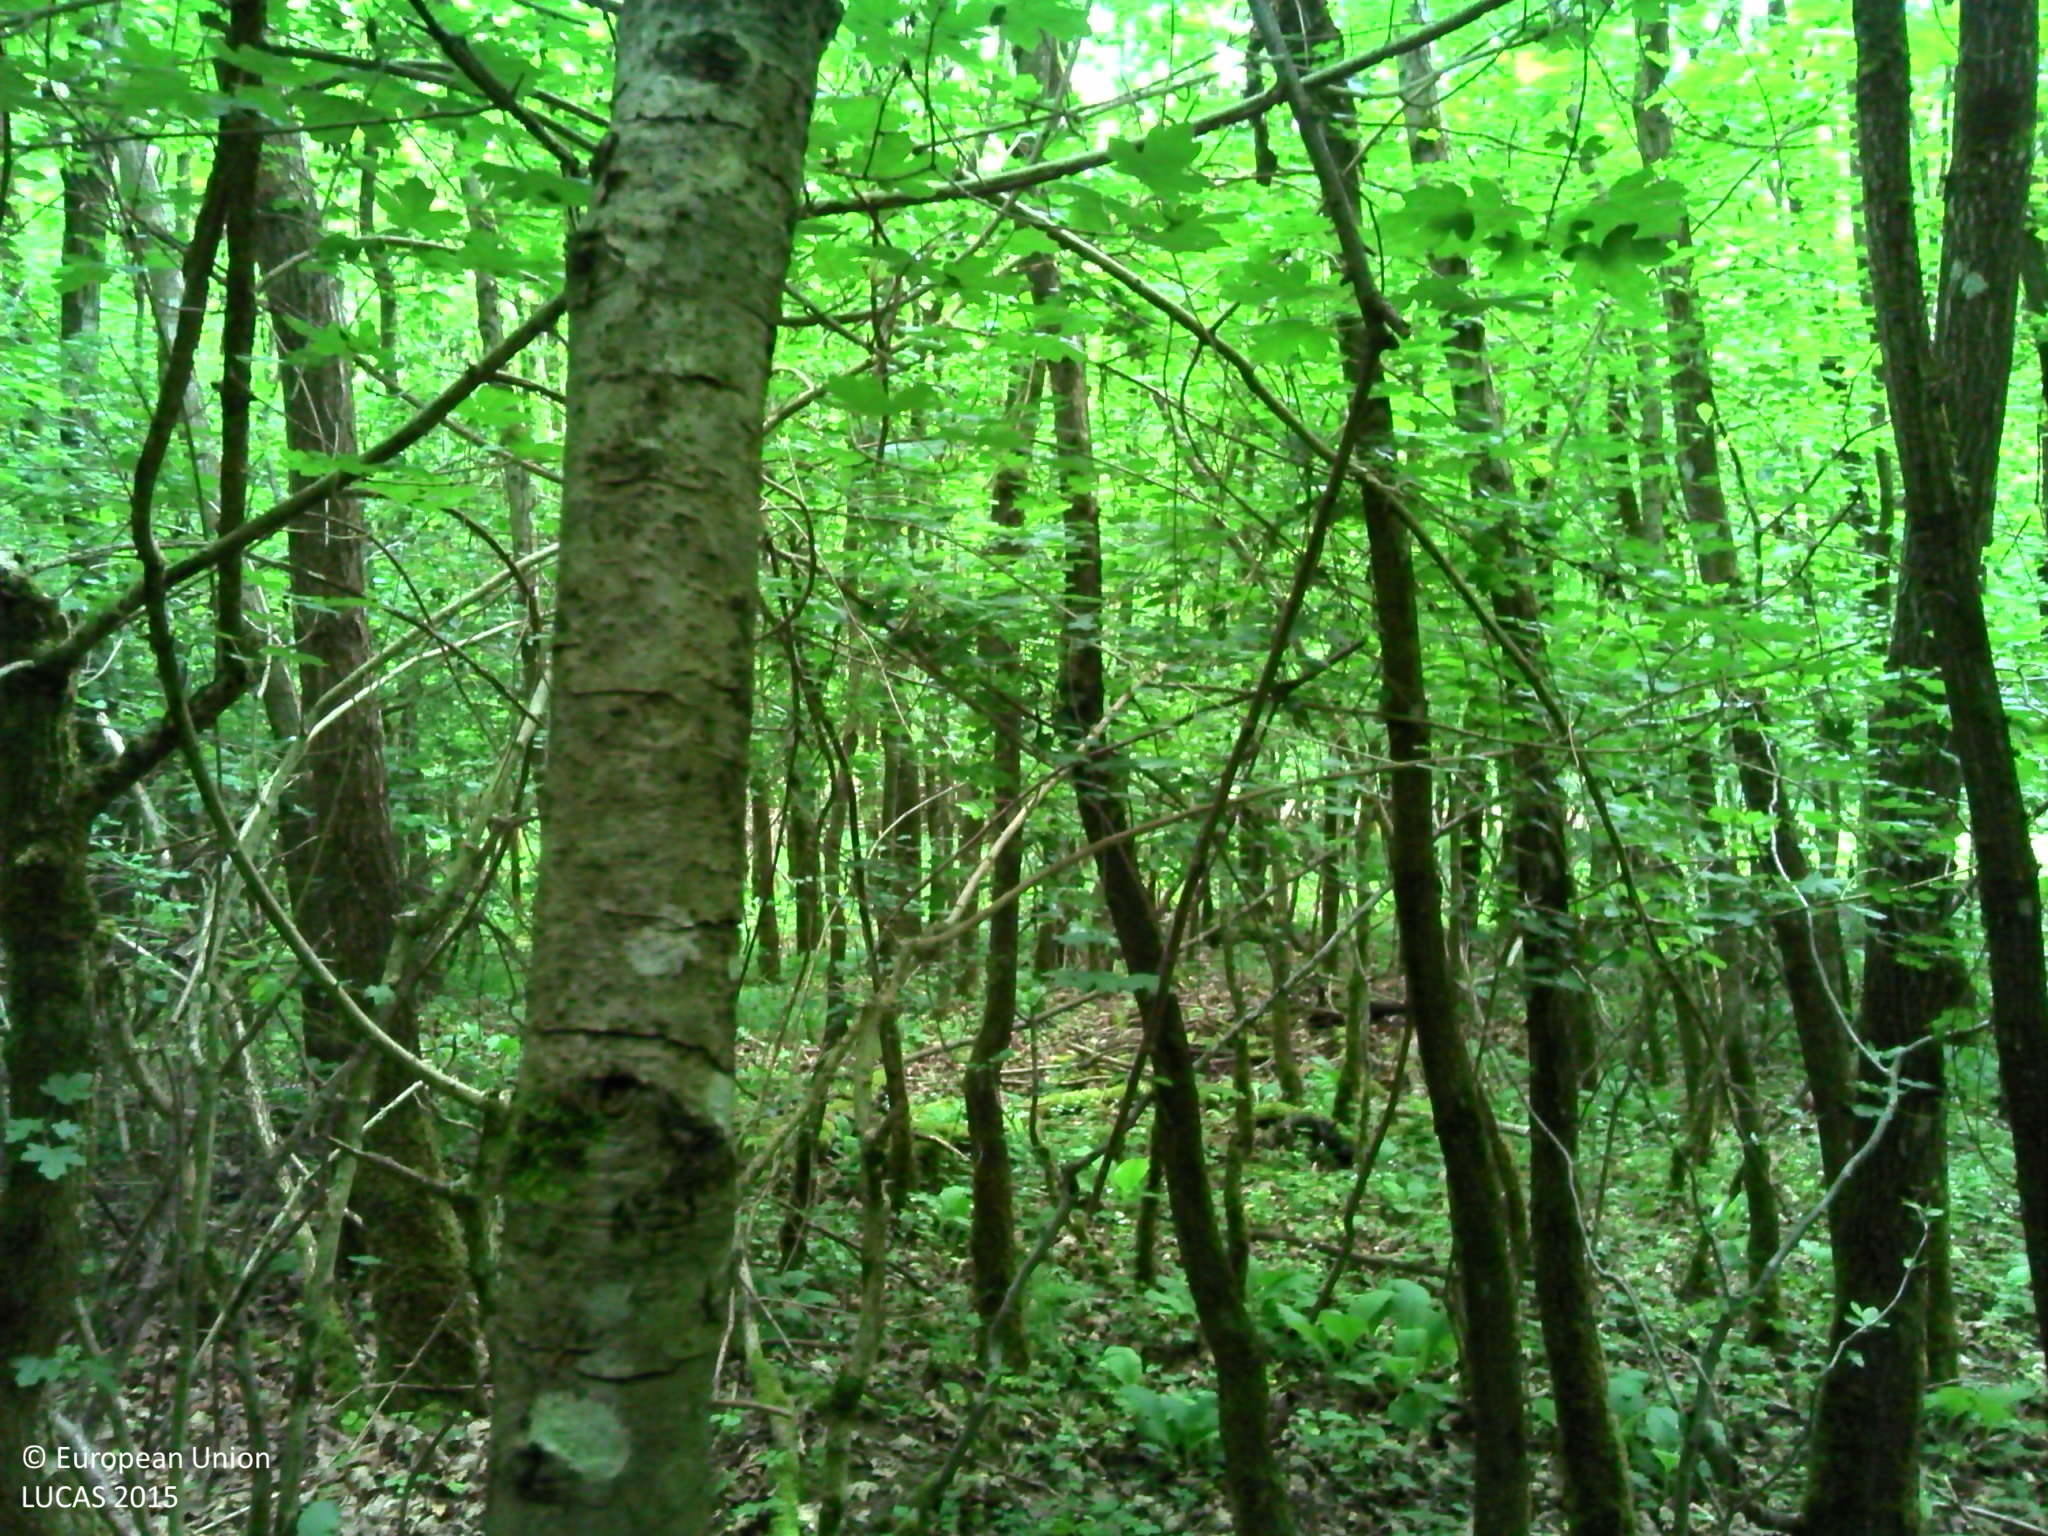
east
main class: Woodland
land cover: Broadleaved woodland
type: mesophytic deciduous forest
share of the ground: > 75 %
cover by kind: broadleaved forest trees 90 %, herbaceous plants 5 %, lichens and mosses 5 %
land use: Forestry
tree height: > 5 m
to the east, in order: Broadleaved woodland; Tracks; Broadleaved woodland; Ditches and canals; Broadleaved woodland
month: May
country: LU
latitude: 49.6769
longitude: 6.3827
